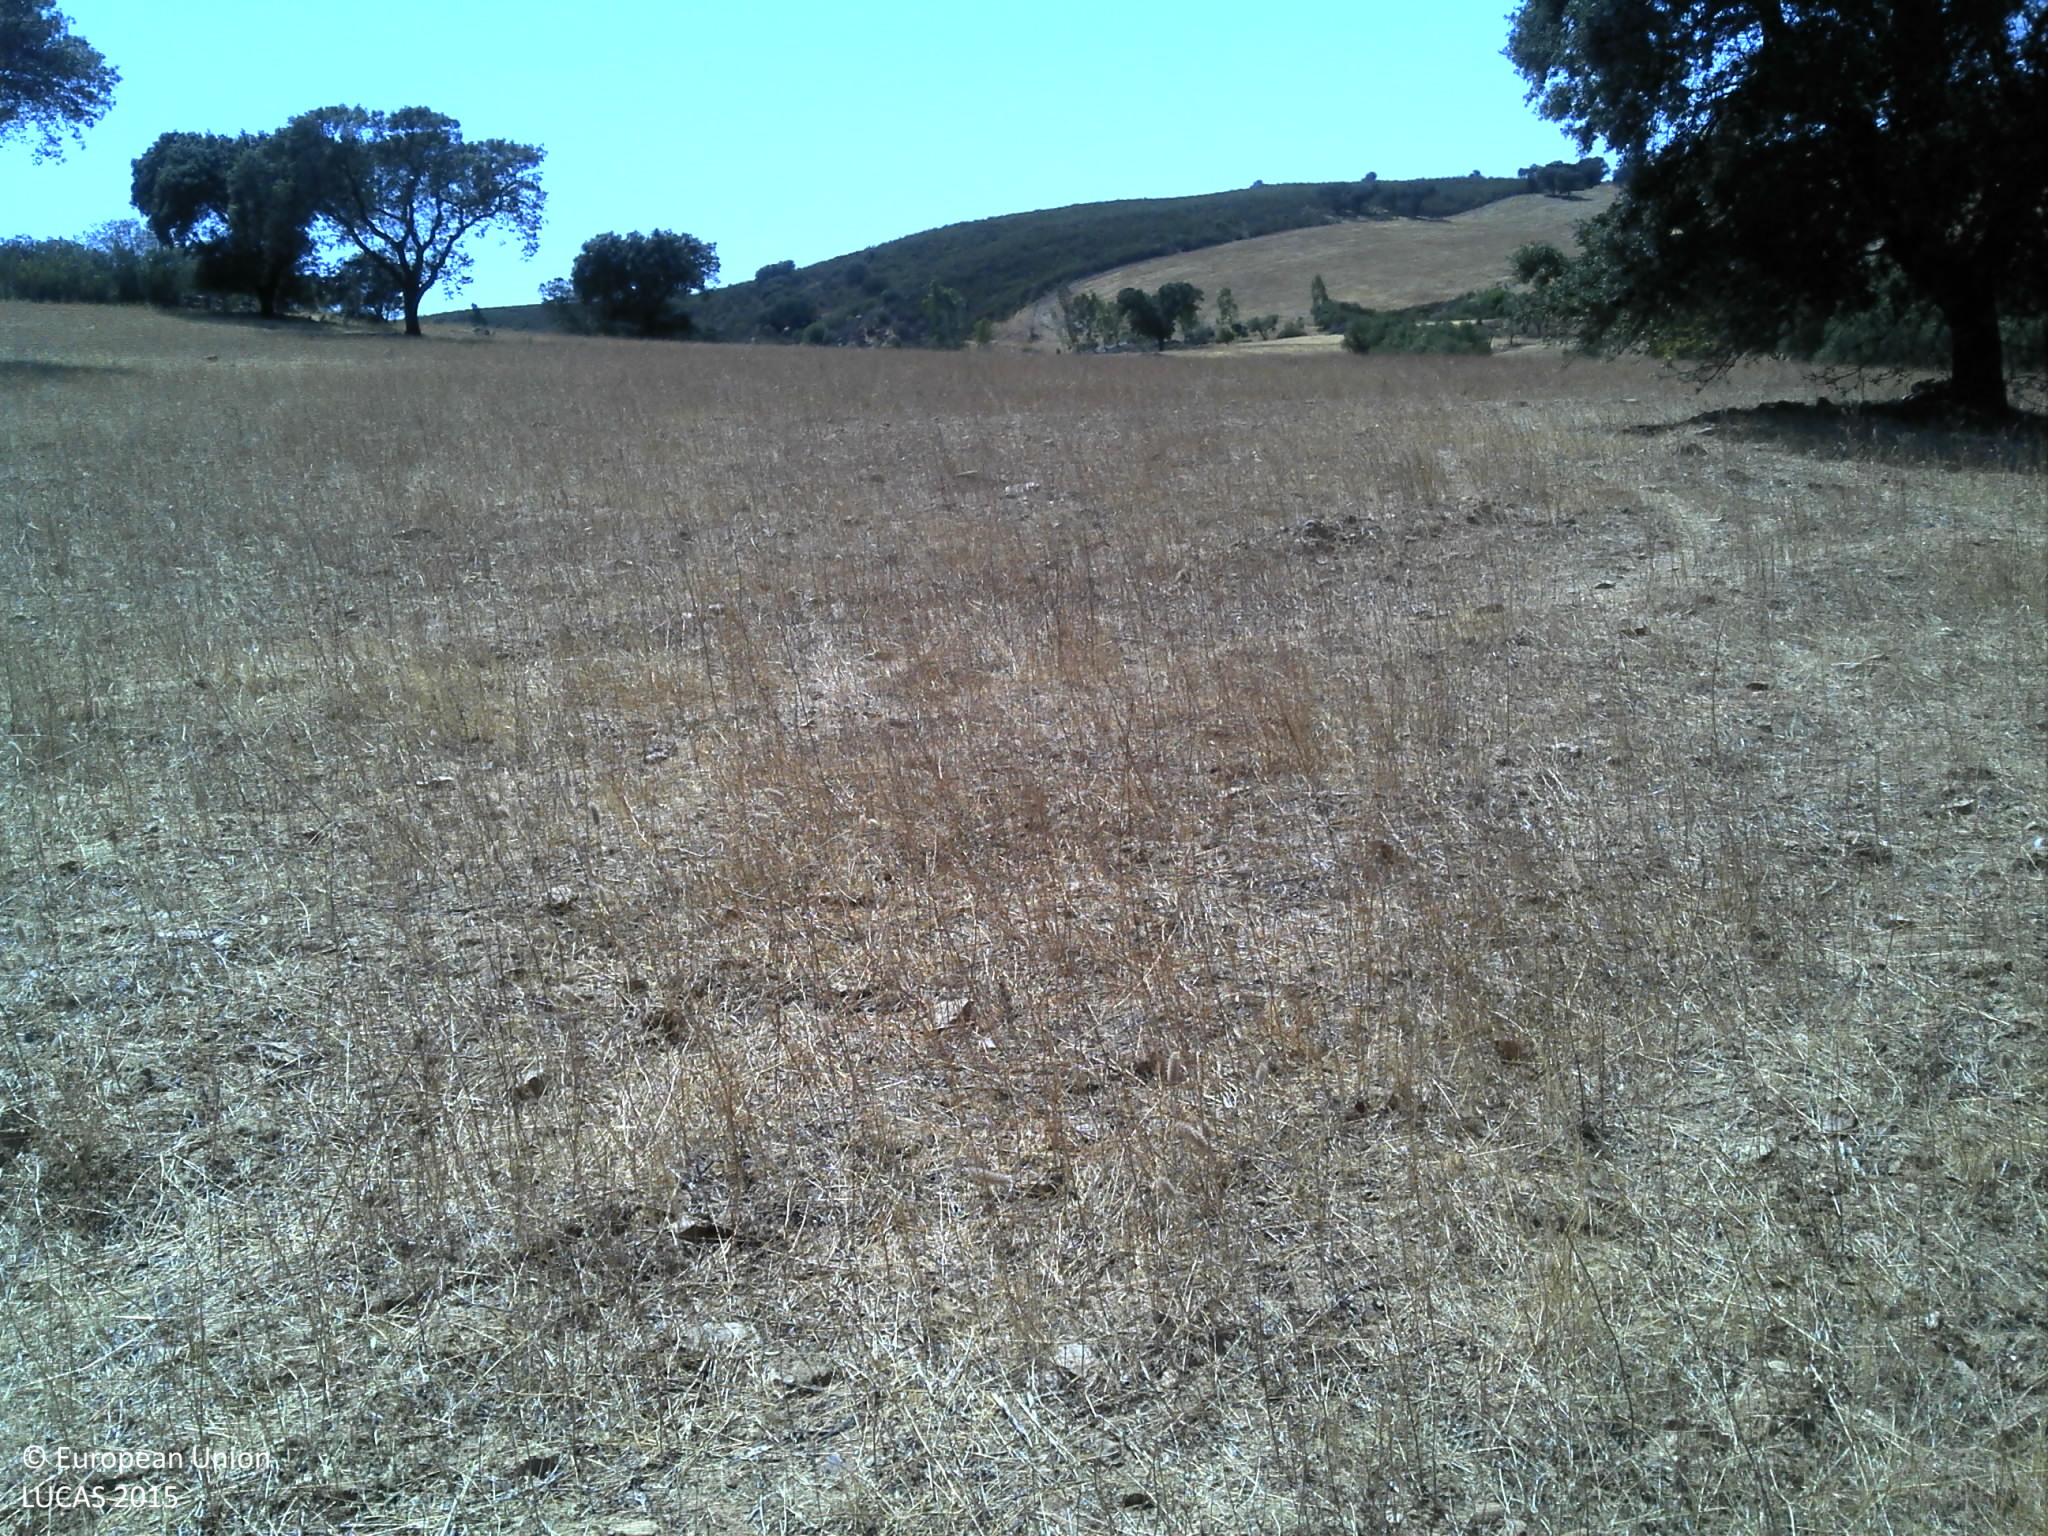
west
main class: Grassland
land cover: Grassland without tree/shrub cover
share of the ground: 10 - 25 %
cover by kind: unconsolidated bare surface 75 %, herbaceous plants 25 %
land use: Agriculture (excluding fallow land and kitchen gardens)
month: July
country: PT
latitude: 37.7863
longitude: -7.9316
